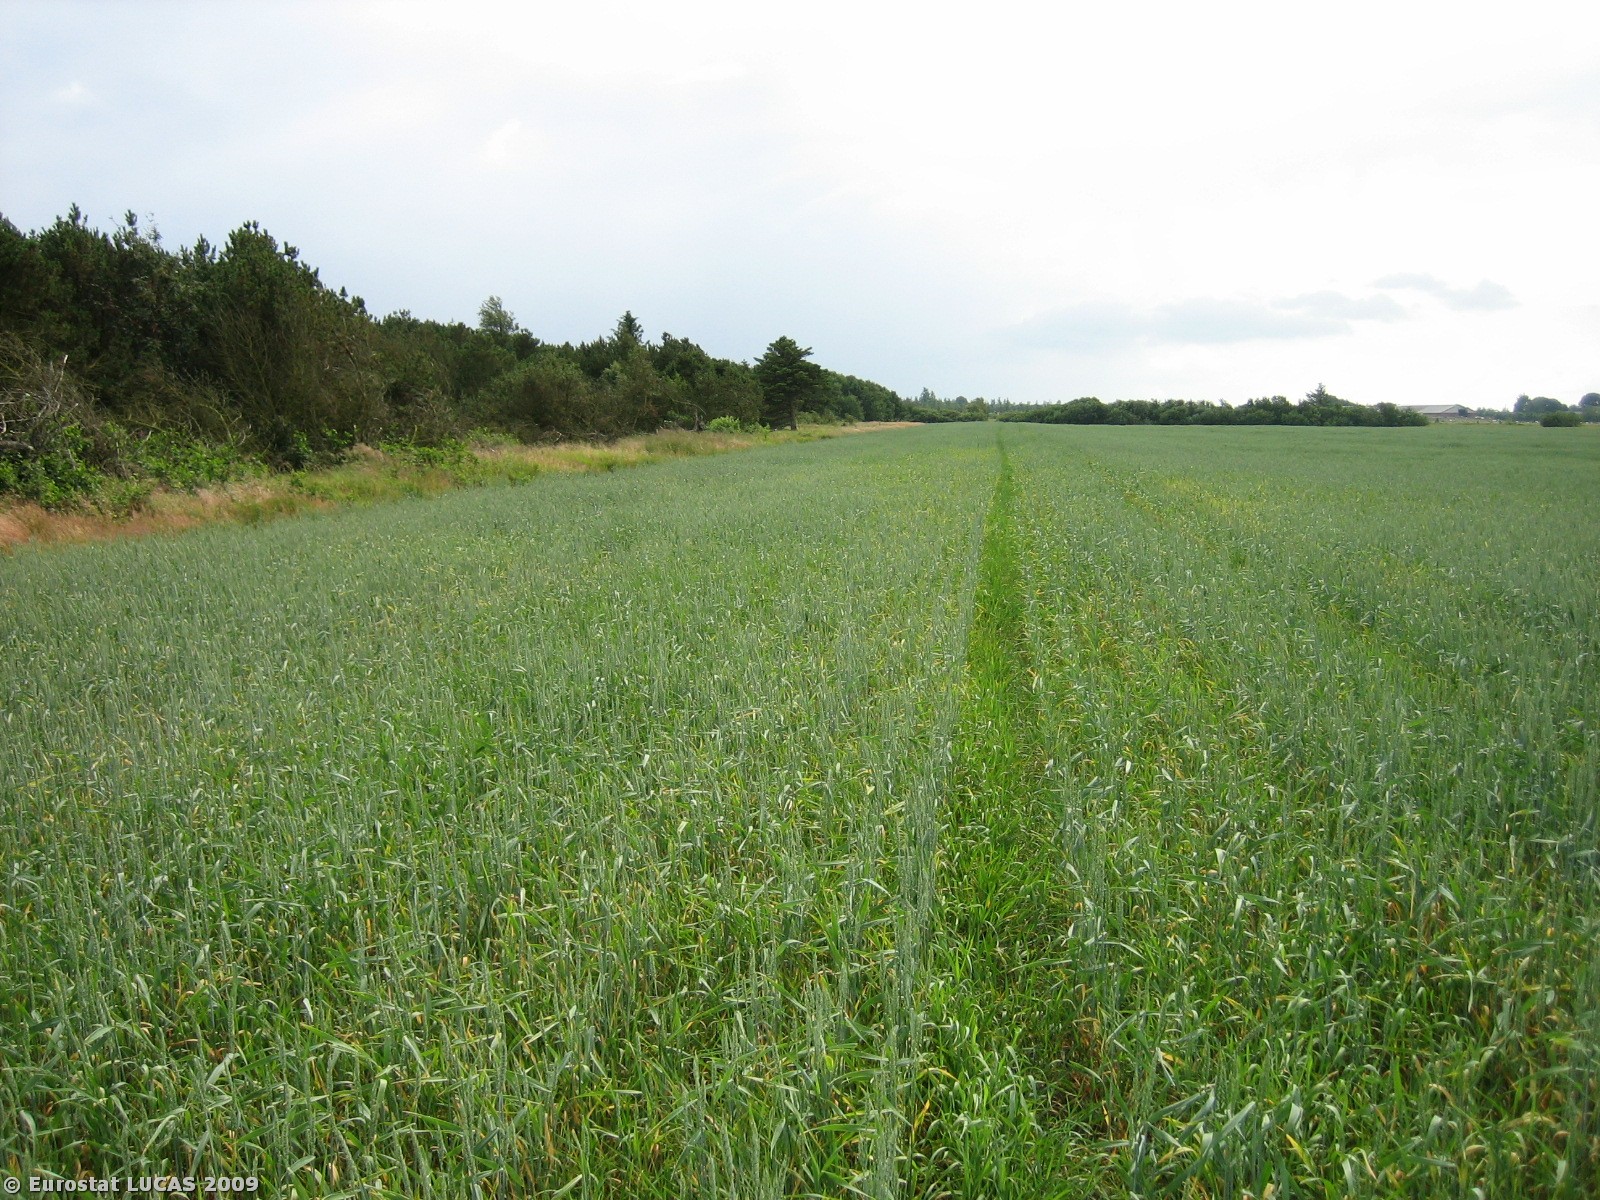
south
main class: Cropland
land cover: Triticale
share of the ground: > 75 %
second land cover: Spontaneously vegetated surfaces
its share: 50 - 75 %
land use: Agriculture (excluding fallow land and kitchen gardens)
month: July
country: DK
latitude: 55.6076
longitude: 8.8740
